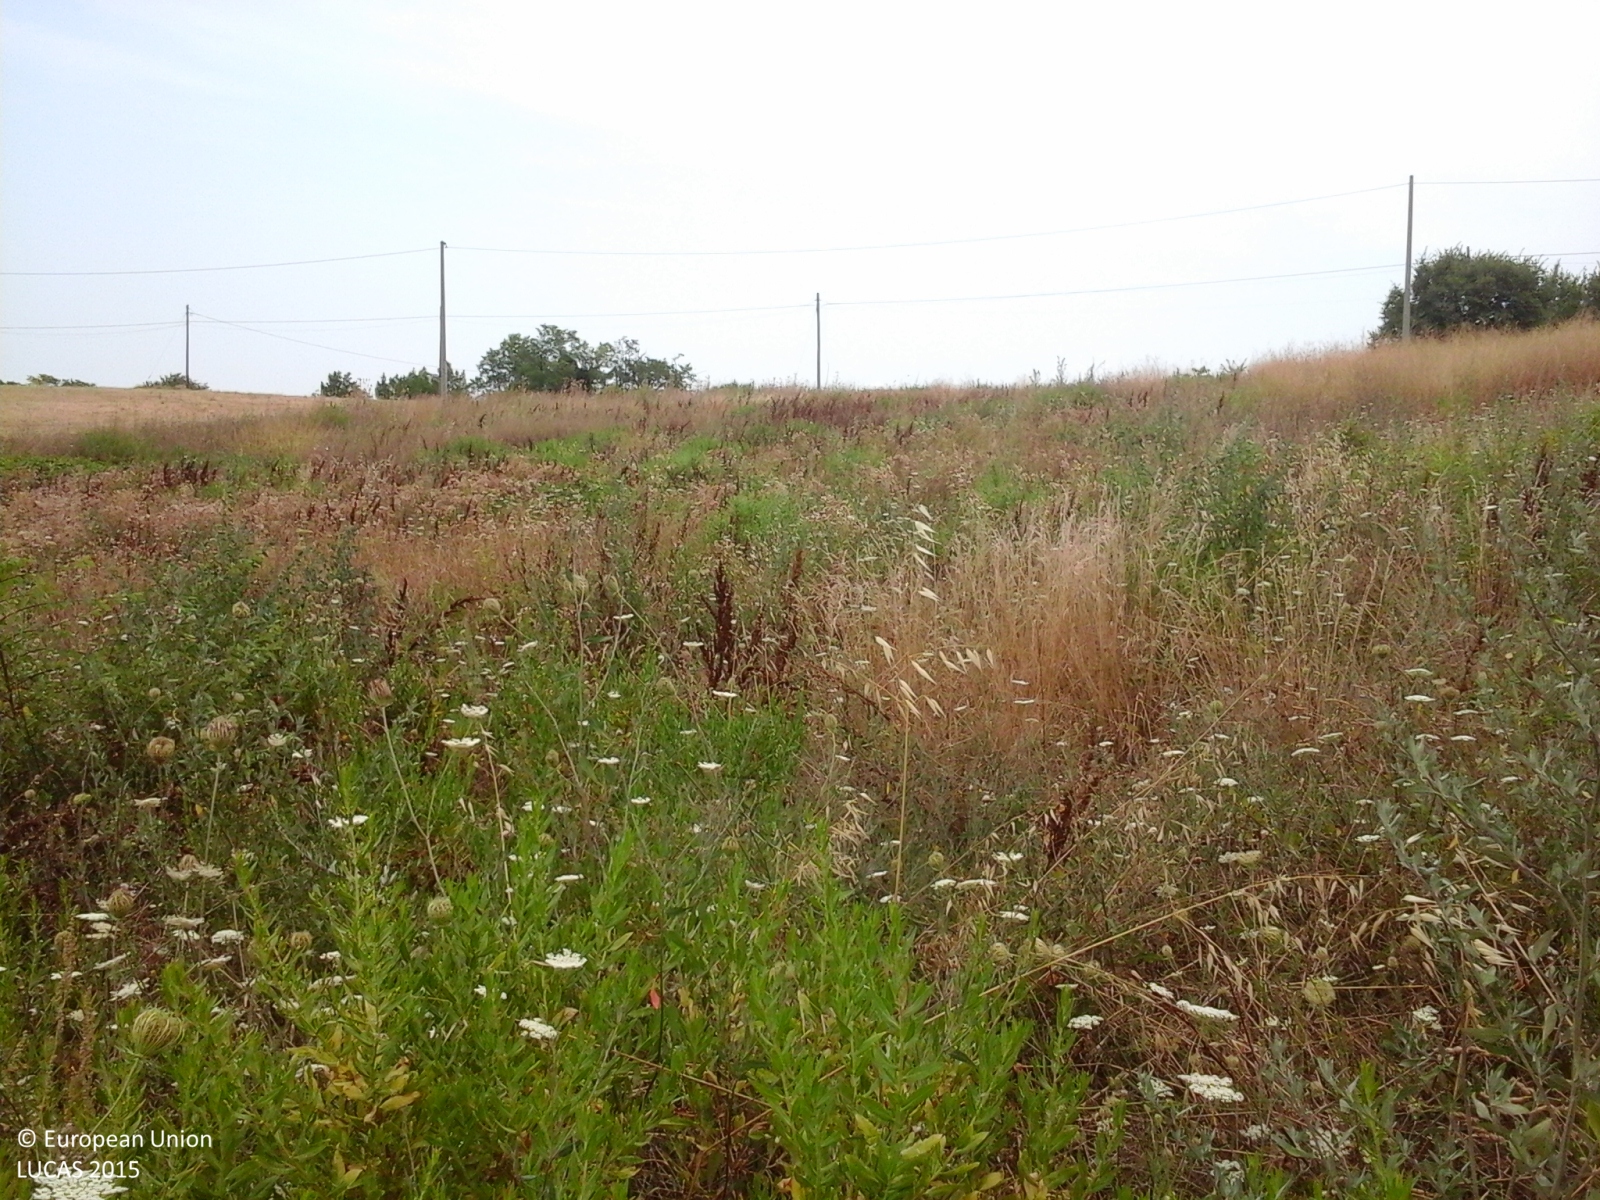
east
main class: Grassland
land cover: Spontaneously vegetated surfaces
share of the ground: > 75 %
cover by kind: herbaceous plants 95 %, shrubs 5 %
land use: Fallow land
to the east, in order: Spontaneously vegetated surfaces; Electric lines; Spontaneously vegetated surfaces; Electric lines; Spontaneously vegetated surfaces; Paved roads, cycling and walking lanes; Durum wheat; Tracks; Durum wheat; Electric lines; Durum wheat; Managed hedges; Grassland with sparse tree/shrub cover; Artificial constructions in urban areas; Grassland without tree/shrub cover; Managed hedges; Durum wheat
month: August
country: IT
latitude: 43.4998
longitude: 13.4174
